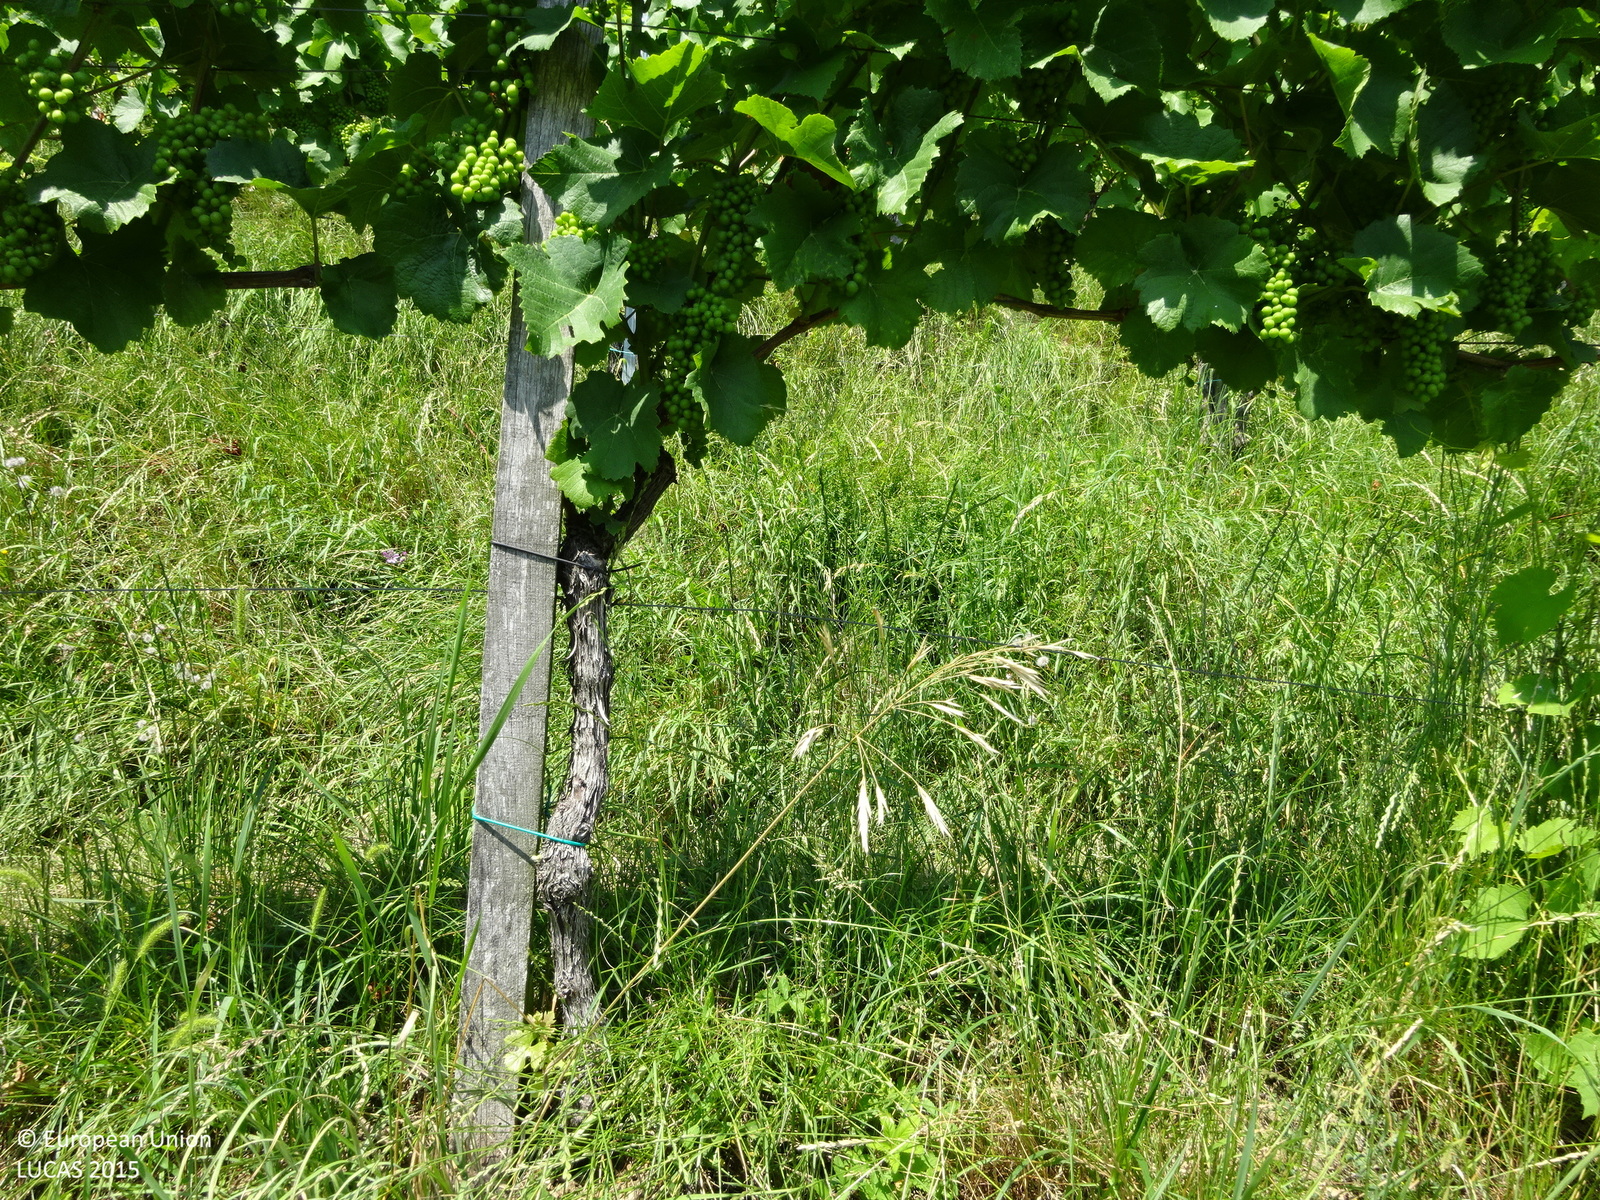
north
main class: Cropland
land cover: Vineyards
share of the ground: 25 - 50 %
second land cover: Grassland without tree/shrub cover
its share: 50 - 75 %
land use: Agriculture (excluding fallow land and kitchen gardens)
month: July
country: AT
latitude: 46.7892
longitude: 15.4619
